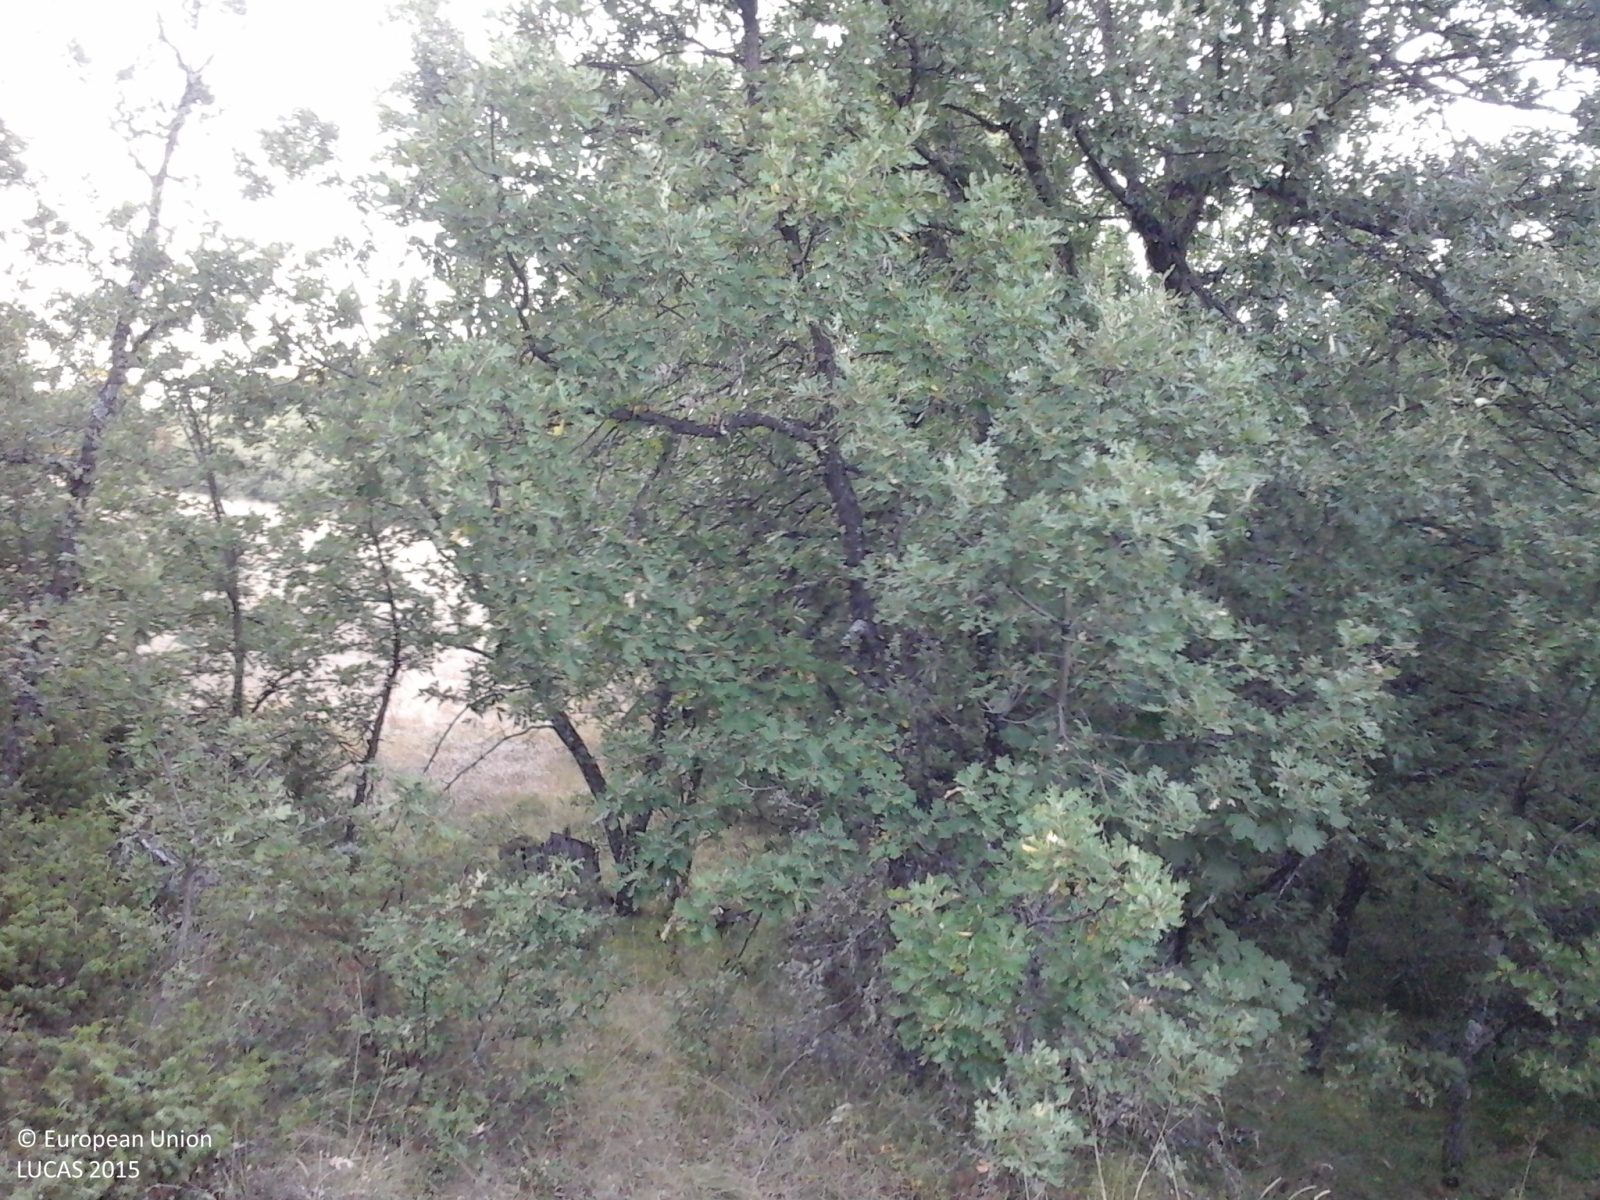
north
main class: Woodland
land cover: Broadleaved woodland
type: thermophilous deciduous forest
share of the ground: > 75 %
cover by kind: broadleaved forest trees 75 %, shrubs 15 %, herbaceous plants 5 %, unconsolidated bare surface 5 %
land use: Forestry
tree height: > 5 m
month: September
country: GR
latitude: 40.0712
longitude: 21.2771
